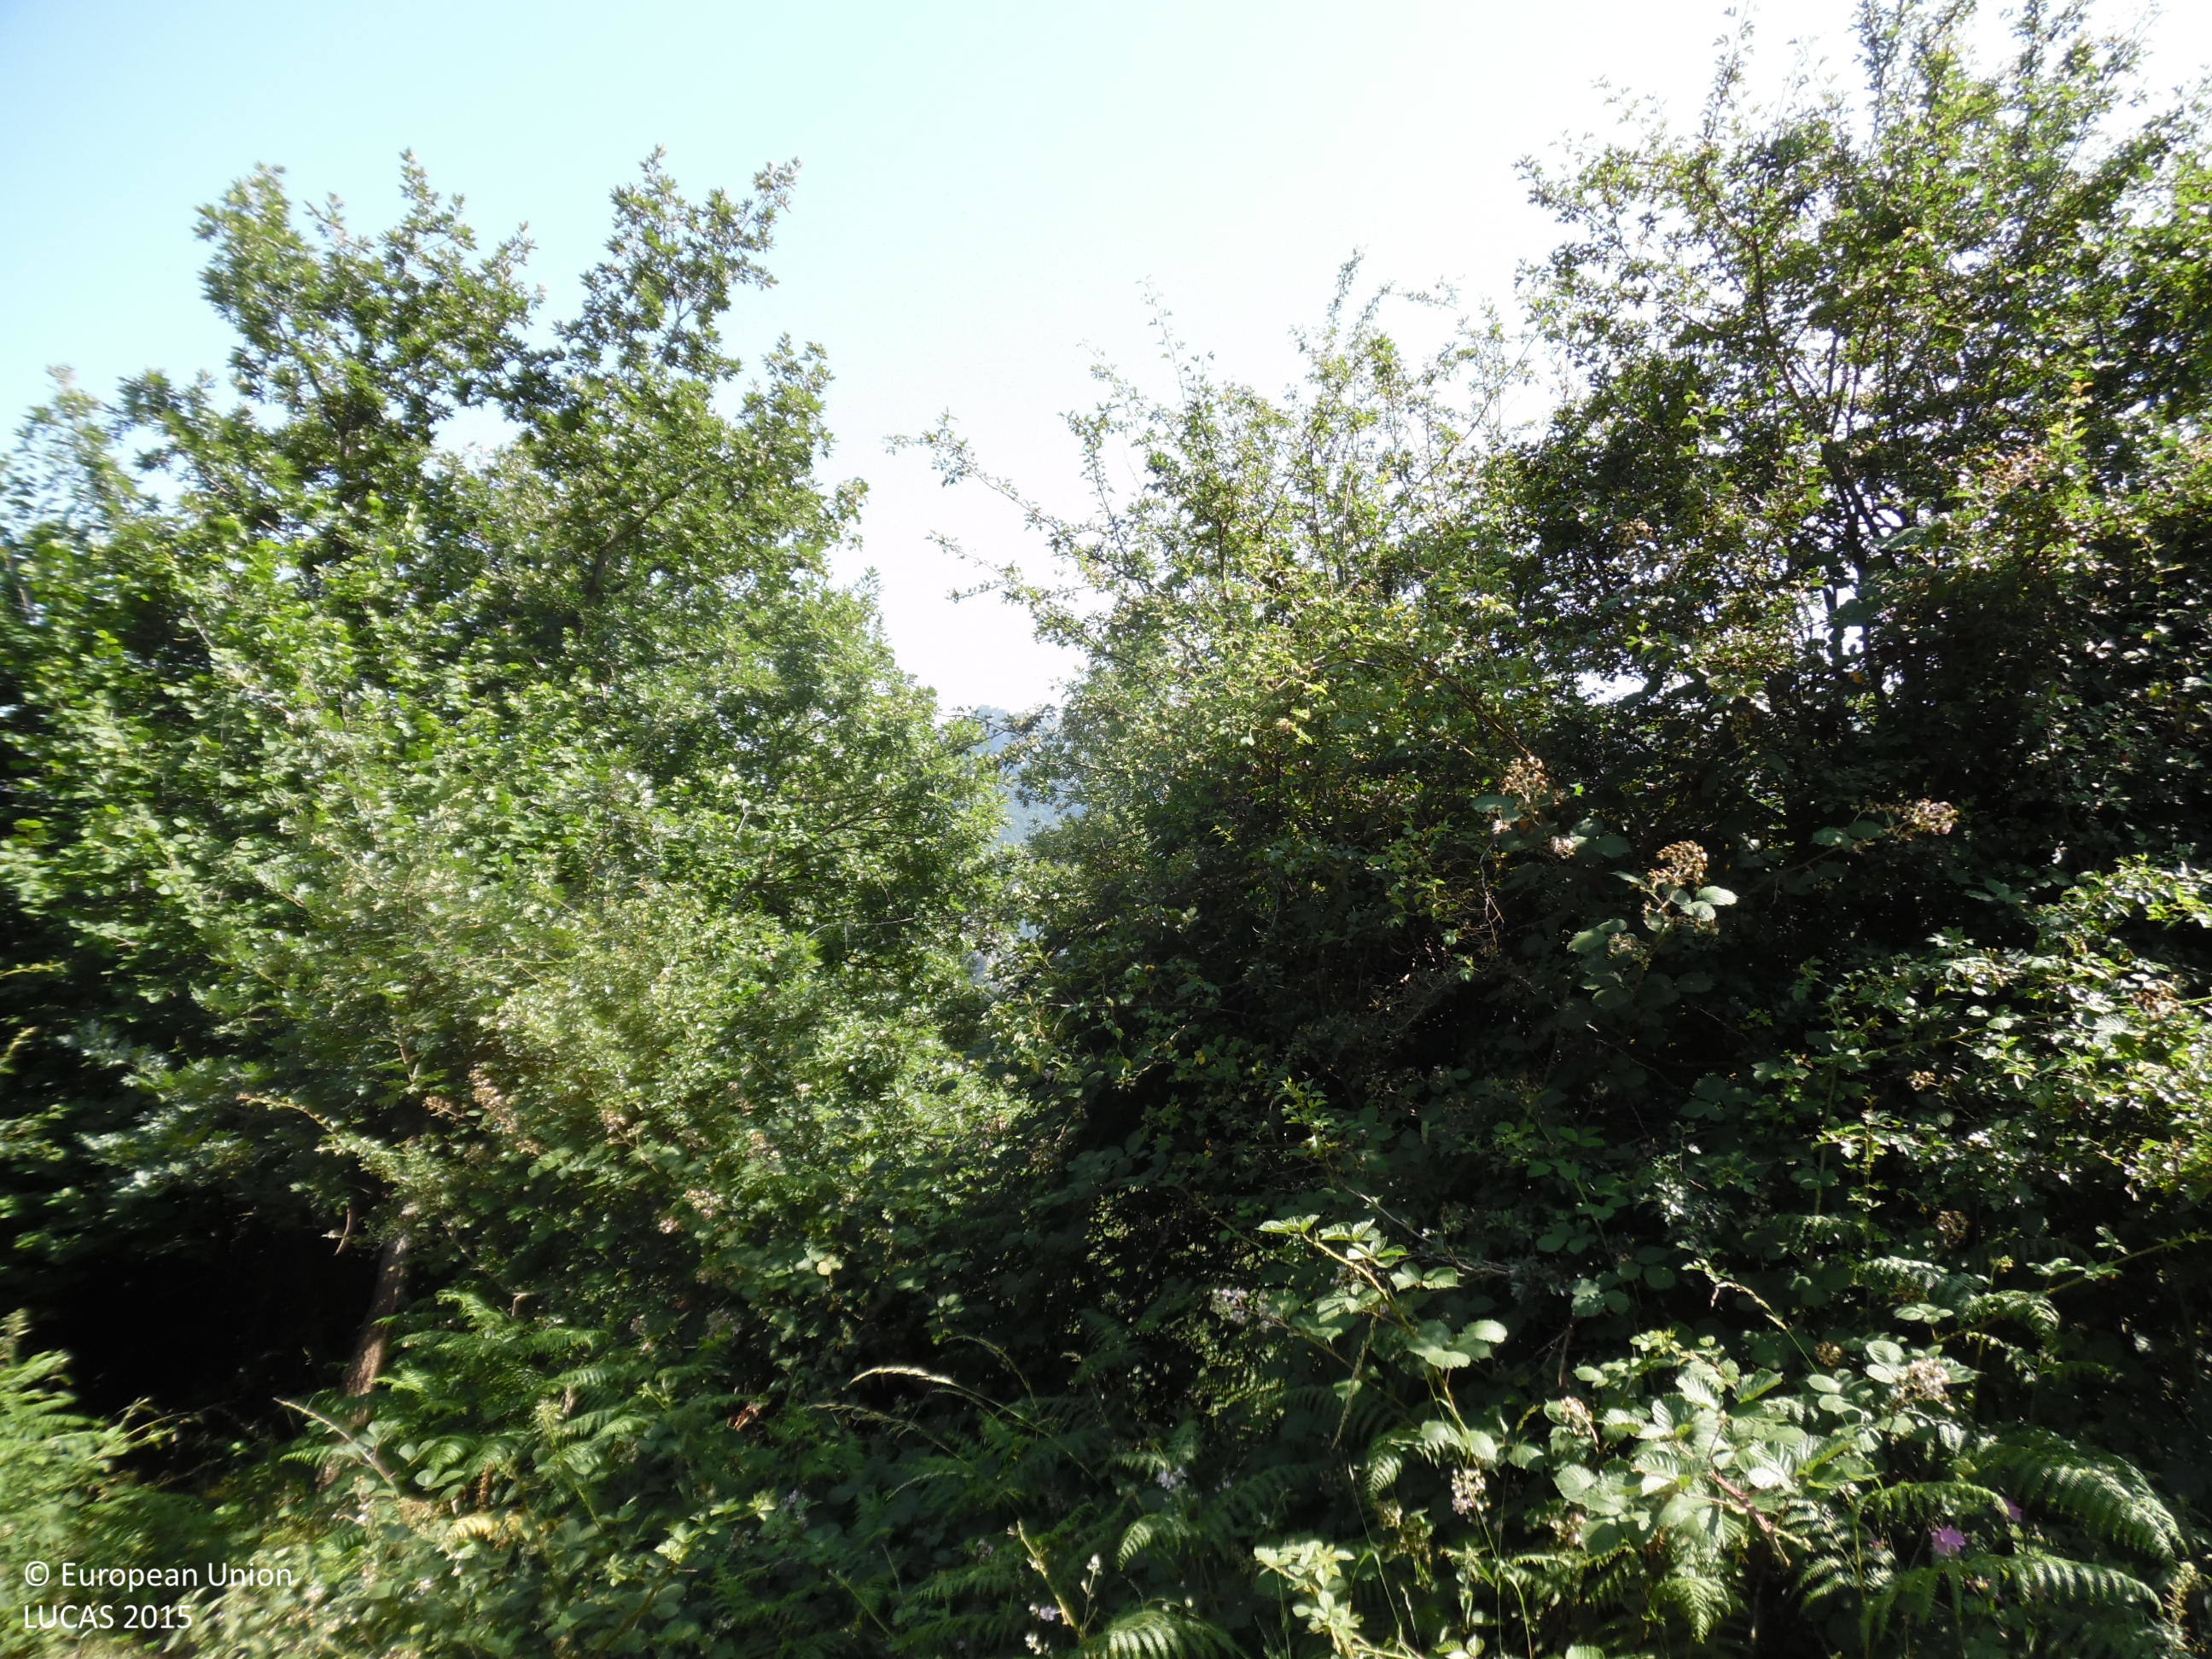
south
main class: Woodland
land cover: Broadleaved woodland
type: thermophilous deciduous forest
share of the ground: > 75 %
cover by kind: broadleaved forest trees 95 %, shrubs 5 %
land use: Forestry
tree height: > 5 m
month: July
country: ES
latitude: 43.1175
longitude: -6.2306
